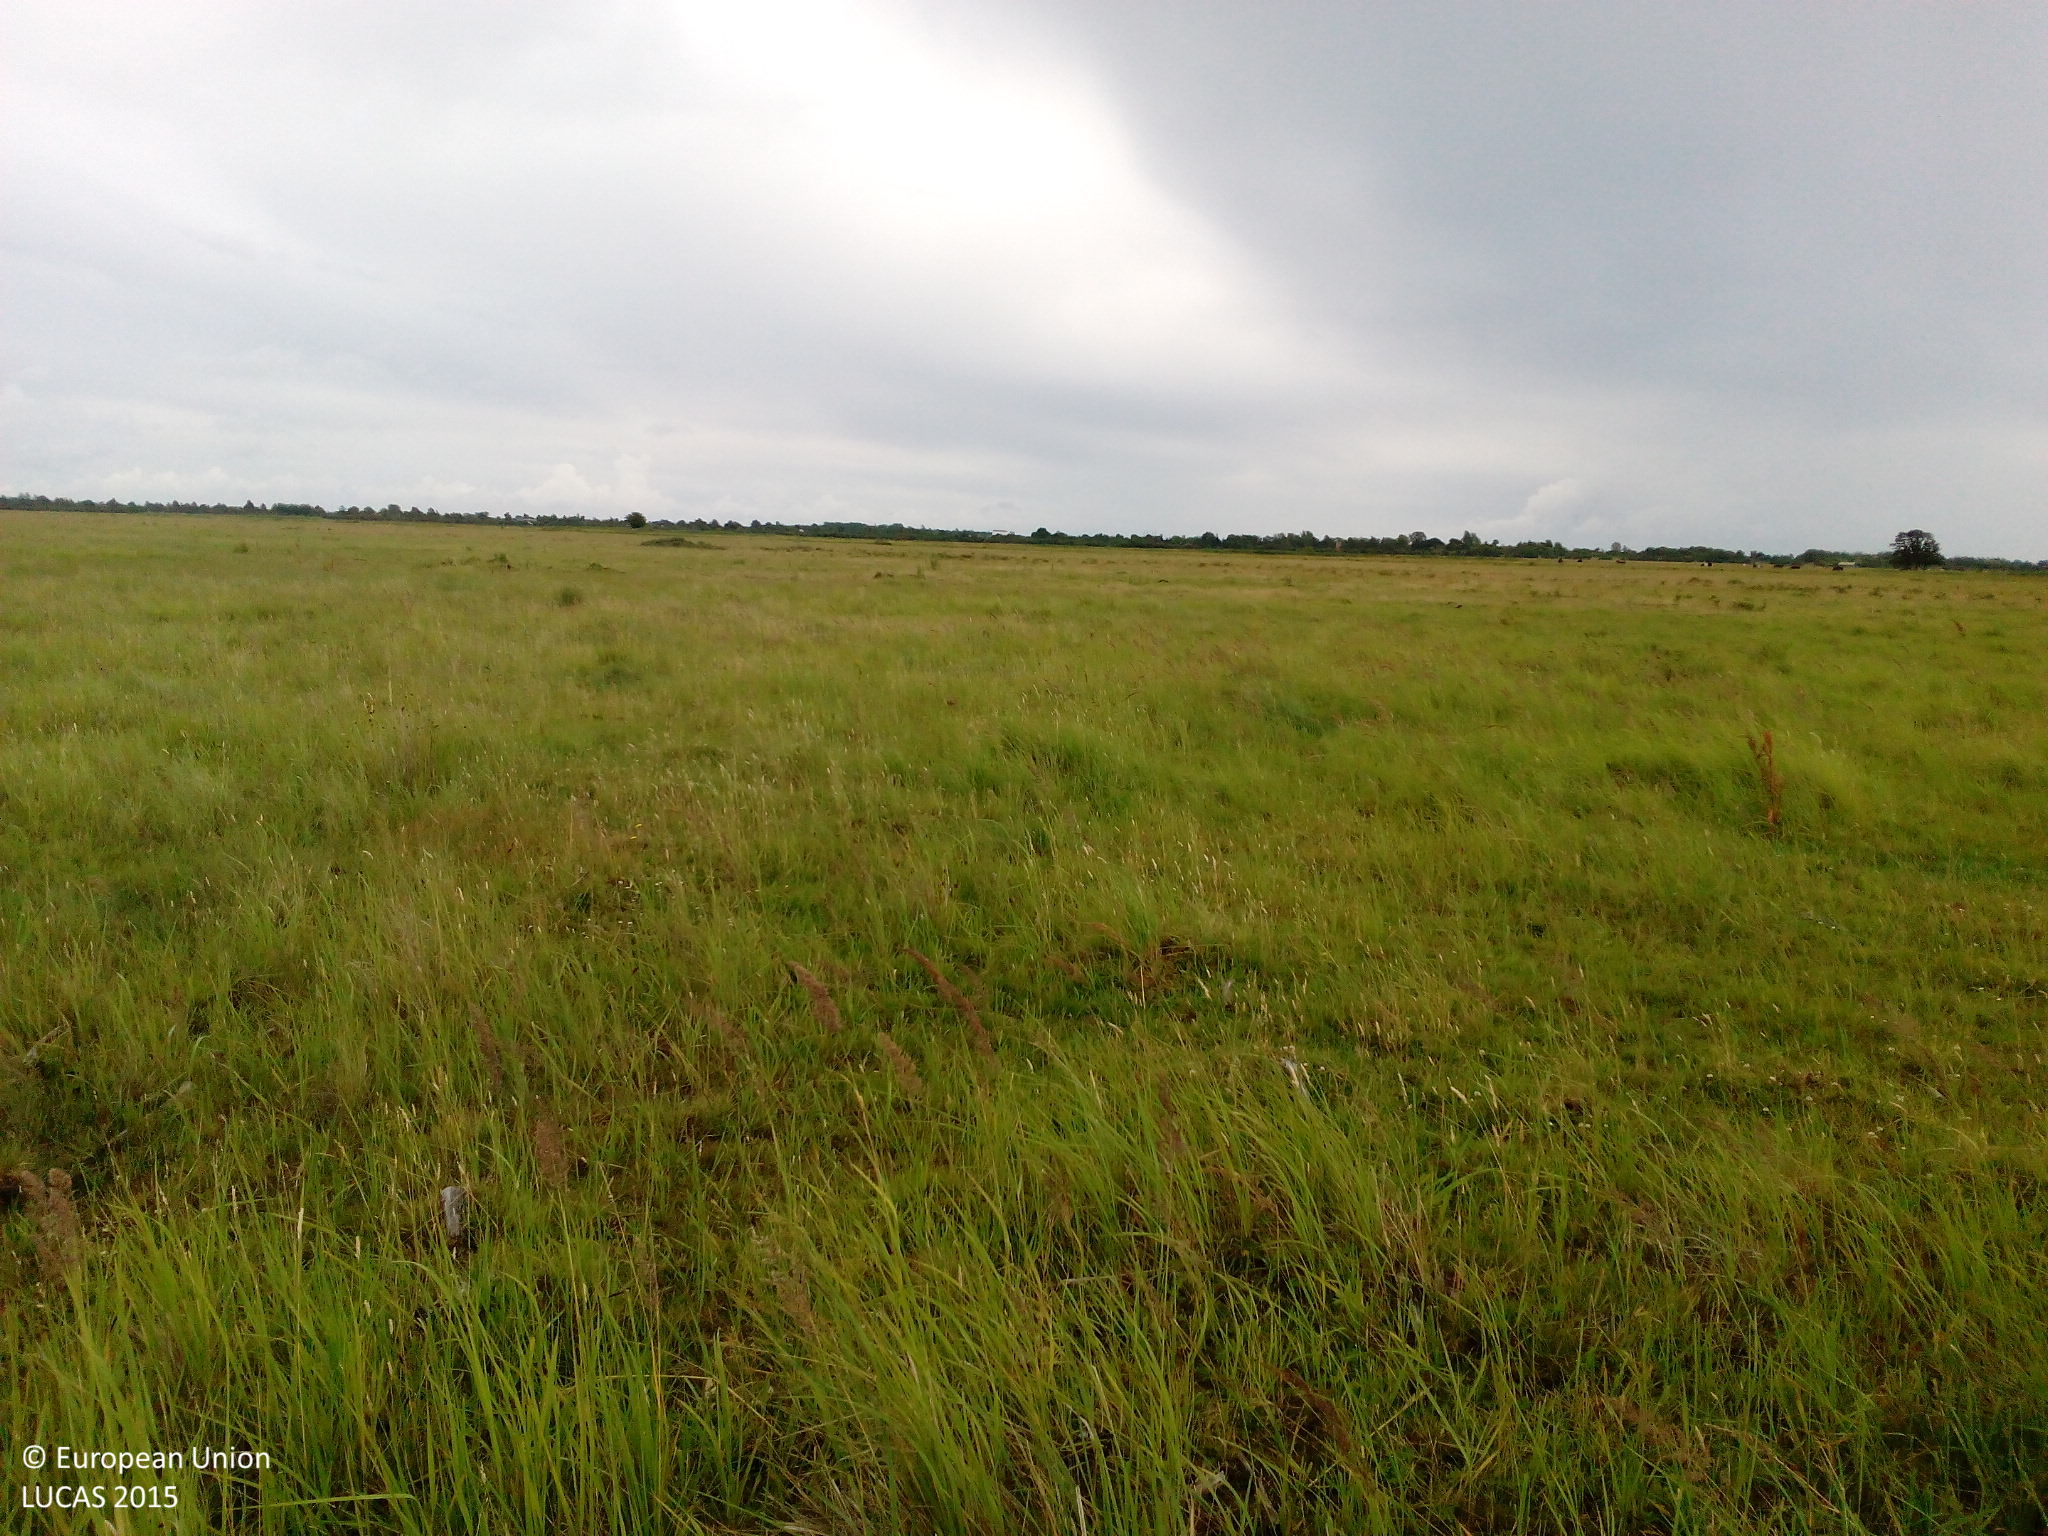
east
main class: Grassland
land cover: Grassland without tree/shrub cover
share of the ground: > 75 %
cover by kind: herbaceous plants 100 %
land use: Agriculture (excluding fallow land and kitchen gardens)
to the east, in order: Grassland without tree/shrub cover; Ditches and canals; Grassland without tree/shrub cover
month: July
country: DK
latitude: 55.6048
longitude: 12.5536
